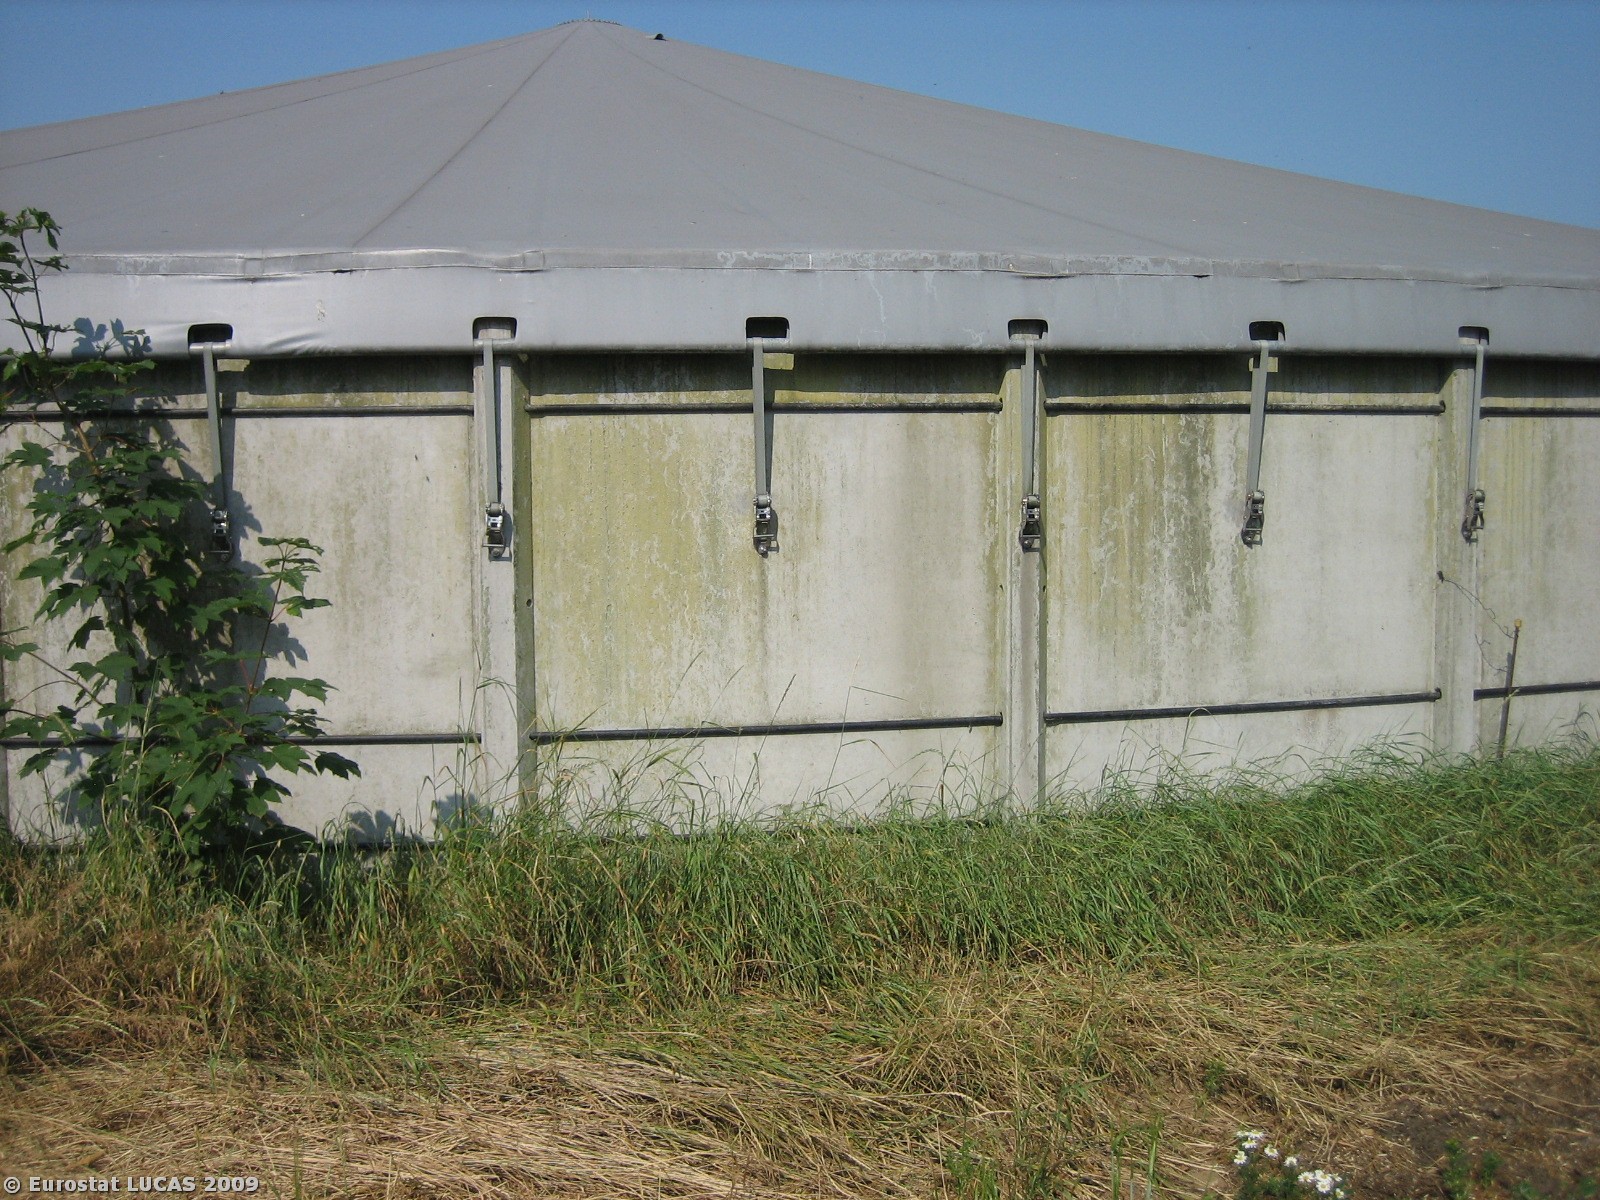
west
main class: Grassland
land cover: Grassland without tree/shrub cover
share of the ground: > 75 %
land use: Agriculture (excluding fallow land and kitchen gardens)
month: July
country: DK
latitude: 55.5187
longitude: 9.0031
